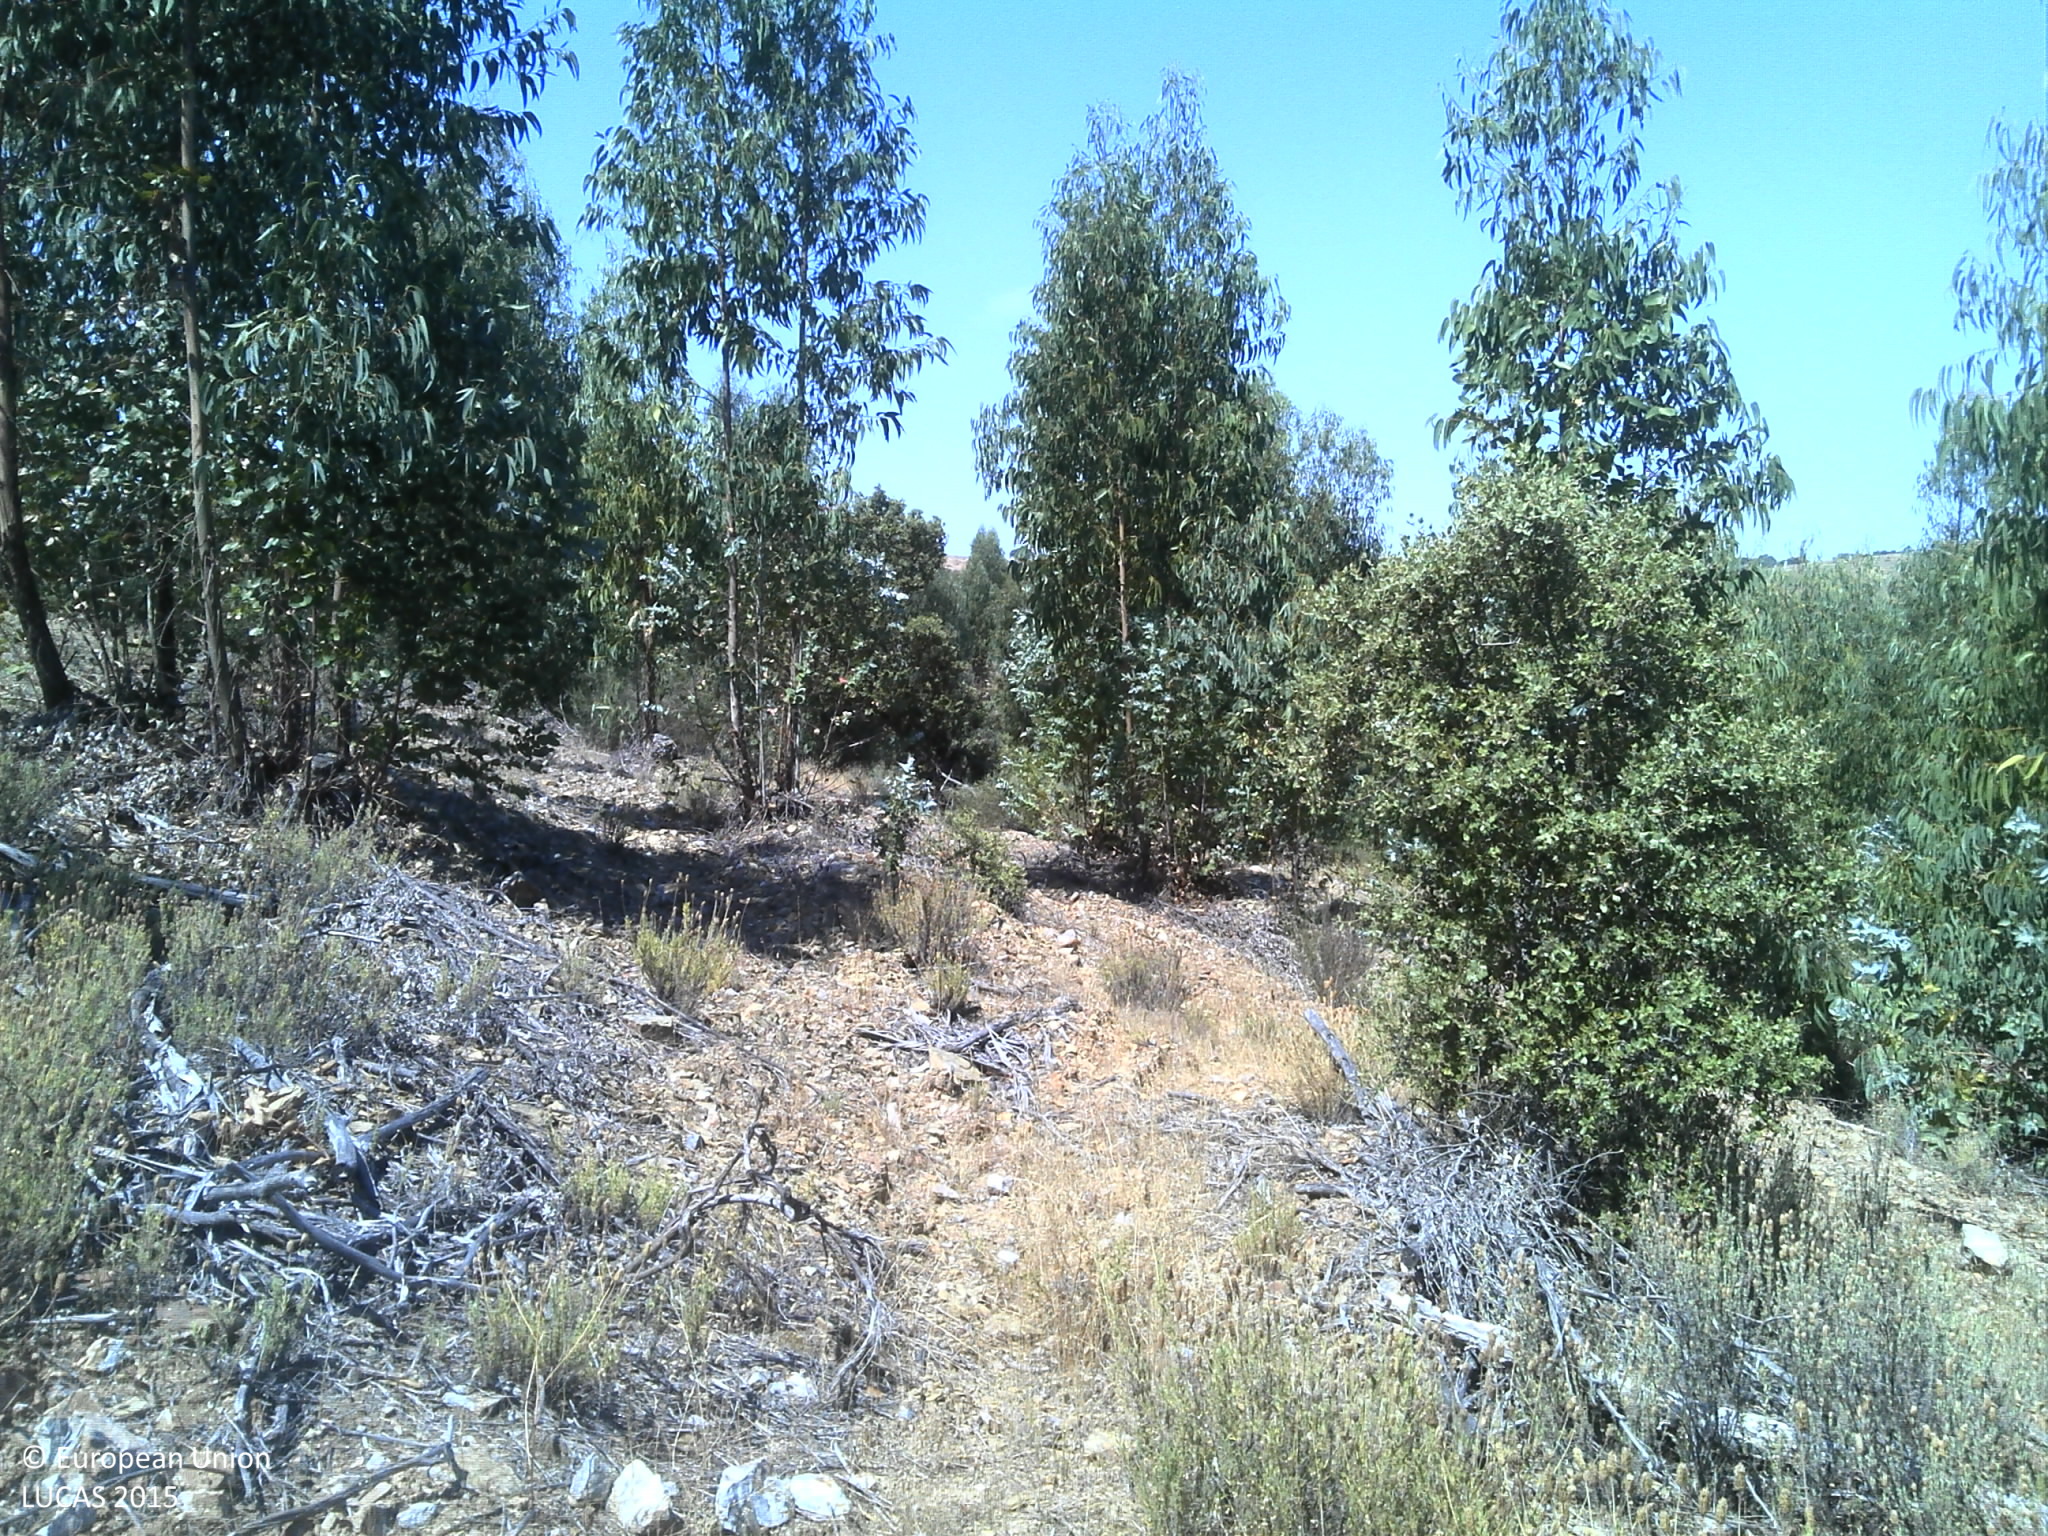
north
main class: Woodland
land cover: Broadleaved woodland
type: exotic forest
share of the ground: 25 - 50 %
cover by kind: broadleaved forest trees 50 %, unconsolidated bare surface 35 %, shrubs 15 %
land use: Forestry
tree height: > 5 m
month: June
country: PT
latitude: 39.7453
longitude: -7.0197
